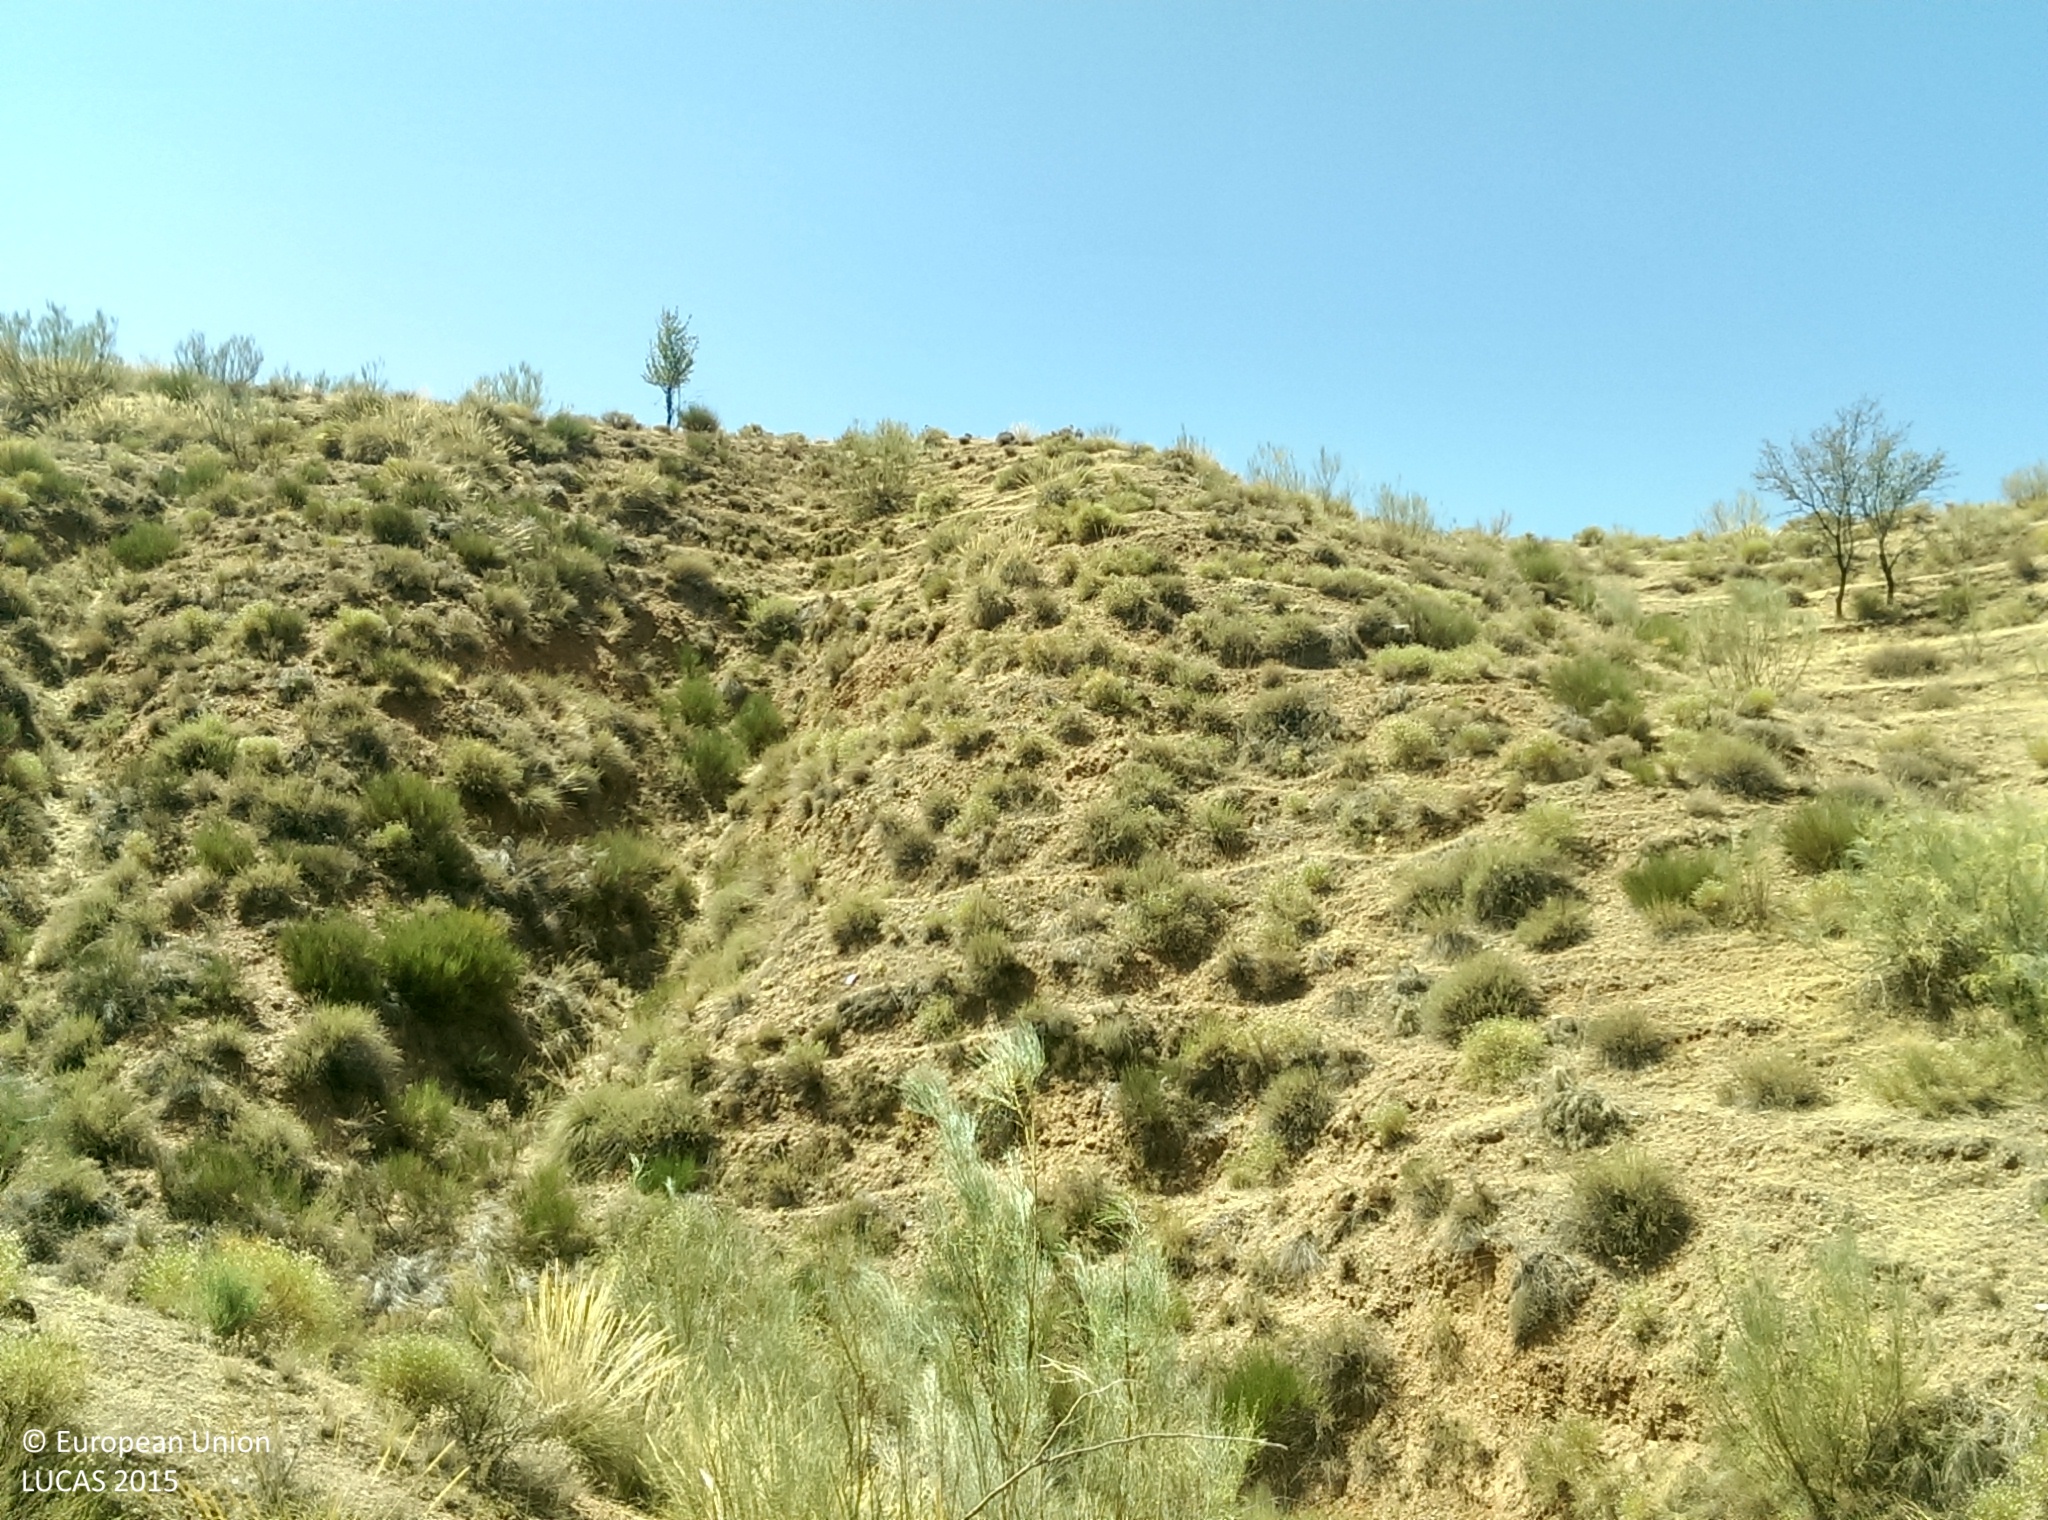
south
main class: Grassland
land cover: Grassland without tree/shrub cover
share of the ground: 50 - 75 %
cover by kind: herbaceous plants 70 %, unconsolidated bare surface 25 %, shrubs 5 %
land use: Semi-natural and natural areas not in use
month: July
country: ES
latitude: 37.2794
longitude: -3.2170
